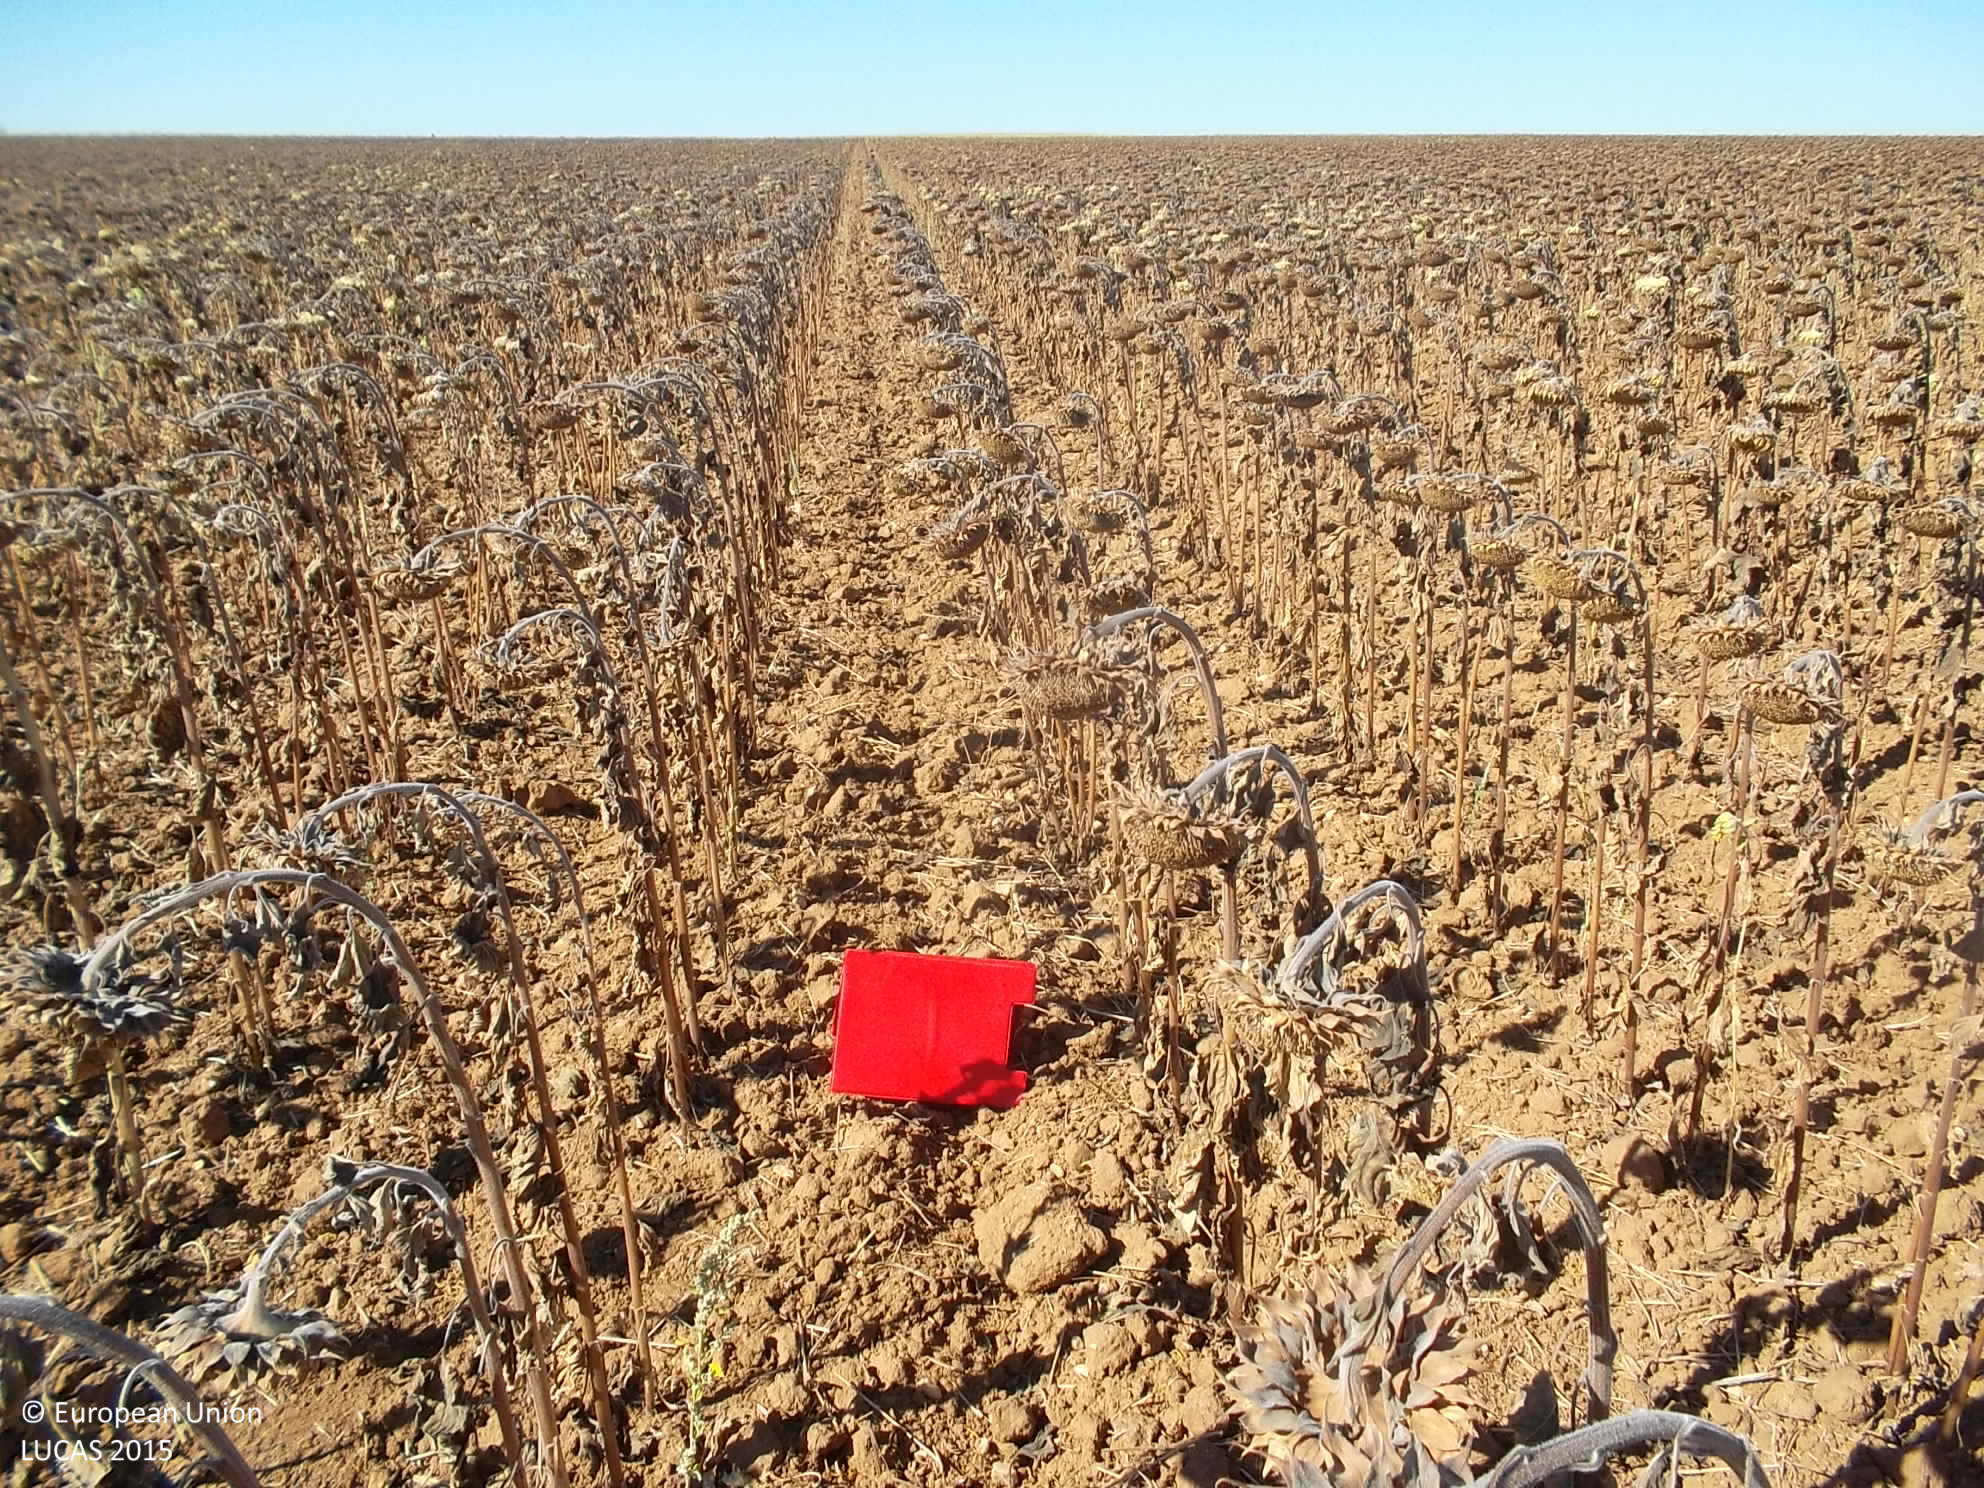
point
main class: Cropland
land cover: Sunflower
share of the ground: > 75 %
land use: Agriculture (excluding fallow land and kitchen gardens)
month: July
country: ES
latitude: 38.4033
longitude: -5.7138
